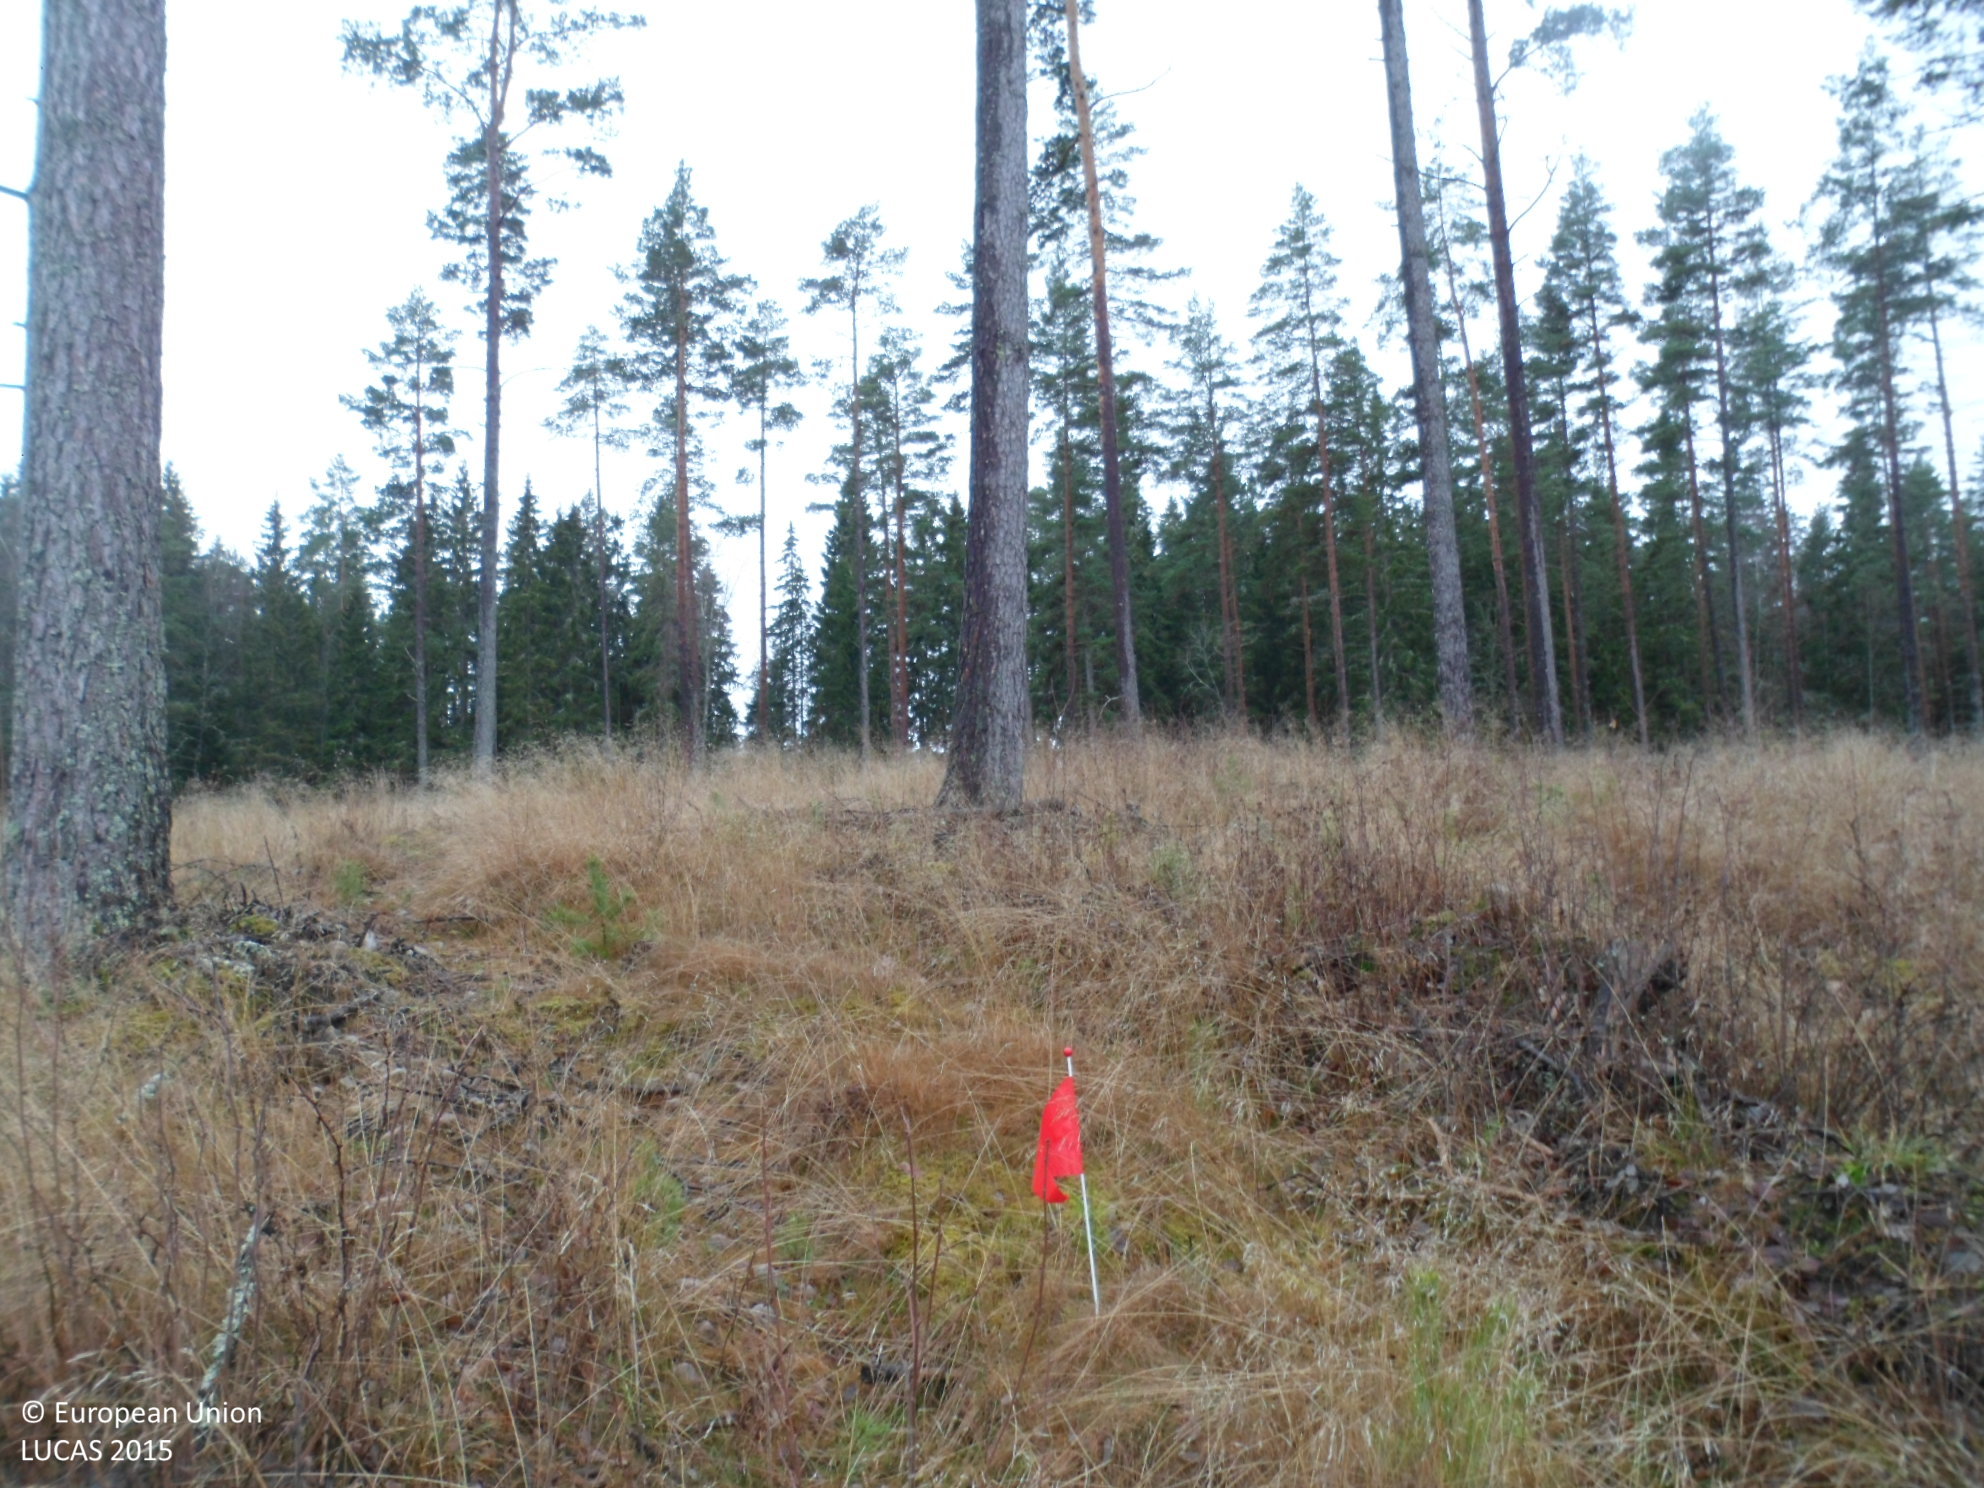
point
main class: Woodland
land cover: Pine dominated coniferous woodland
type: boreal forest
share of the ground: 25 - 50 %
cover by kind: herbaceous plants 40 %, coniferous forest trees 30 %, shrubs 20 %, broadleaved forest trees 5 %, lichens and mosses 5 %
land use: Forestry
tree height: > 5 m
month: November
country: SE
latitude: 57.7703
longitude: 14.8876
